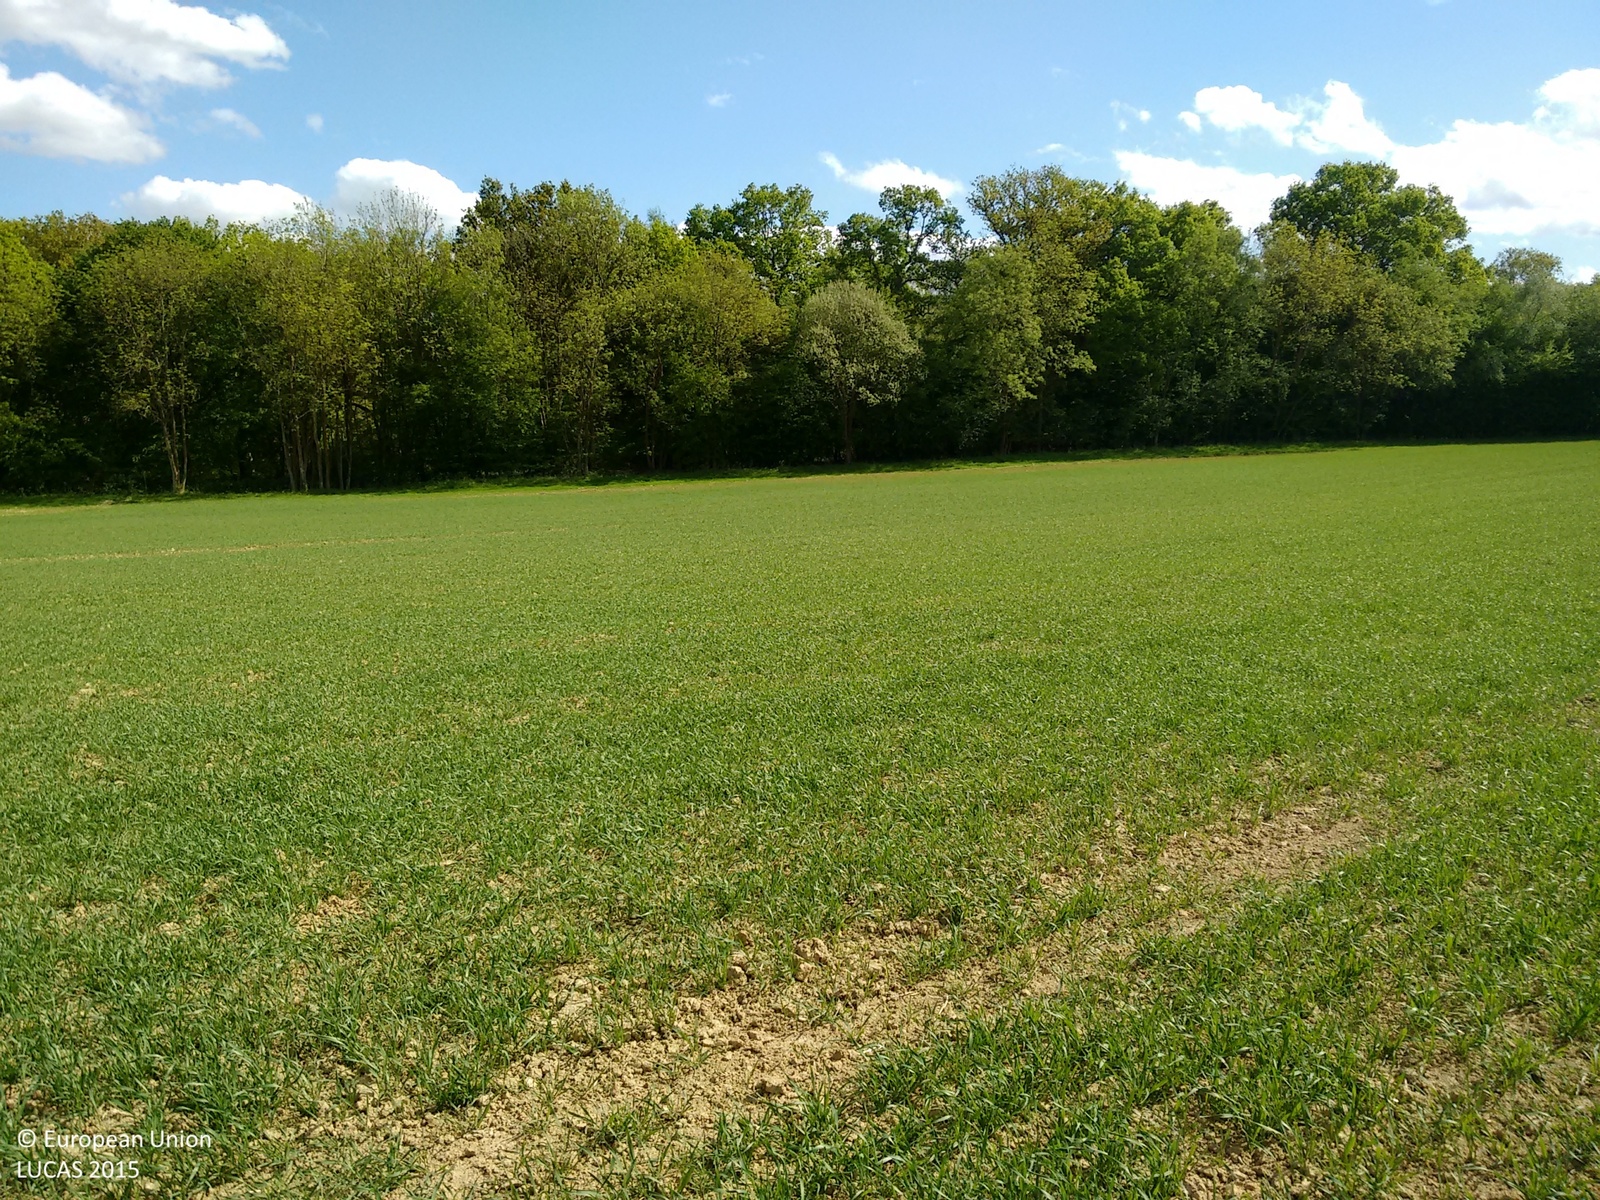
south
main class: Cropland
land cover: Common wheat
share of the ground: 25 - 50 %
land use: Agriculture (excluding fallow land and kitchen gardens)
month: May
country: GB
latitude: 51.2370
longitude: 0.3022
